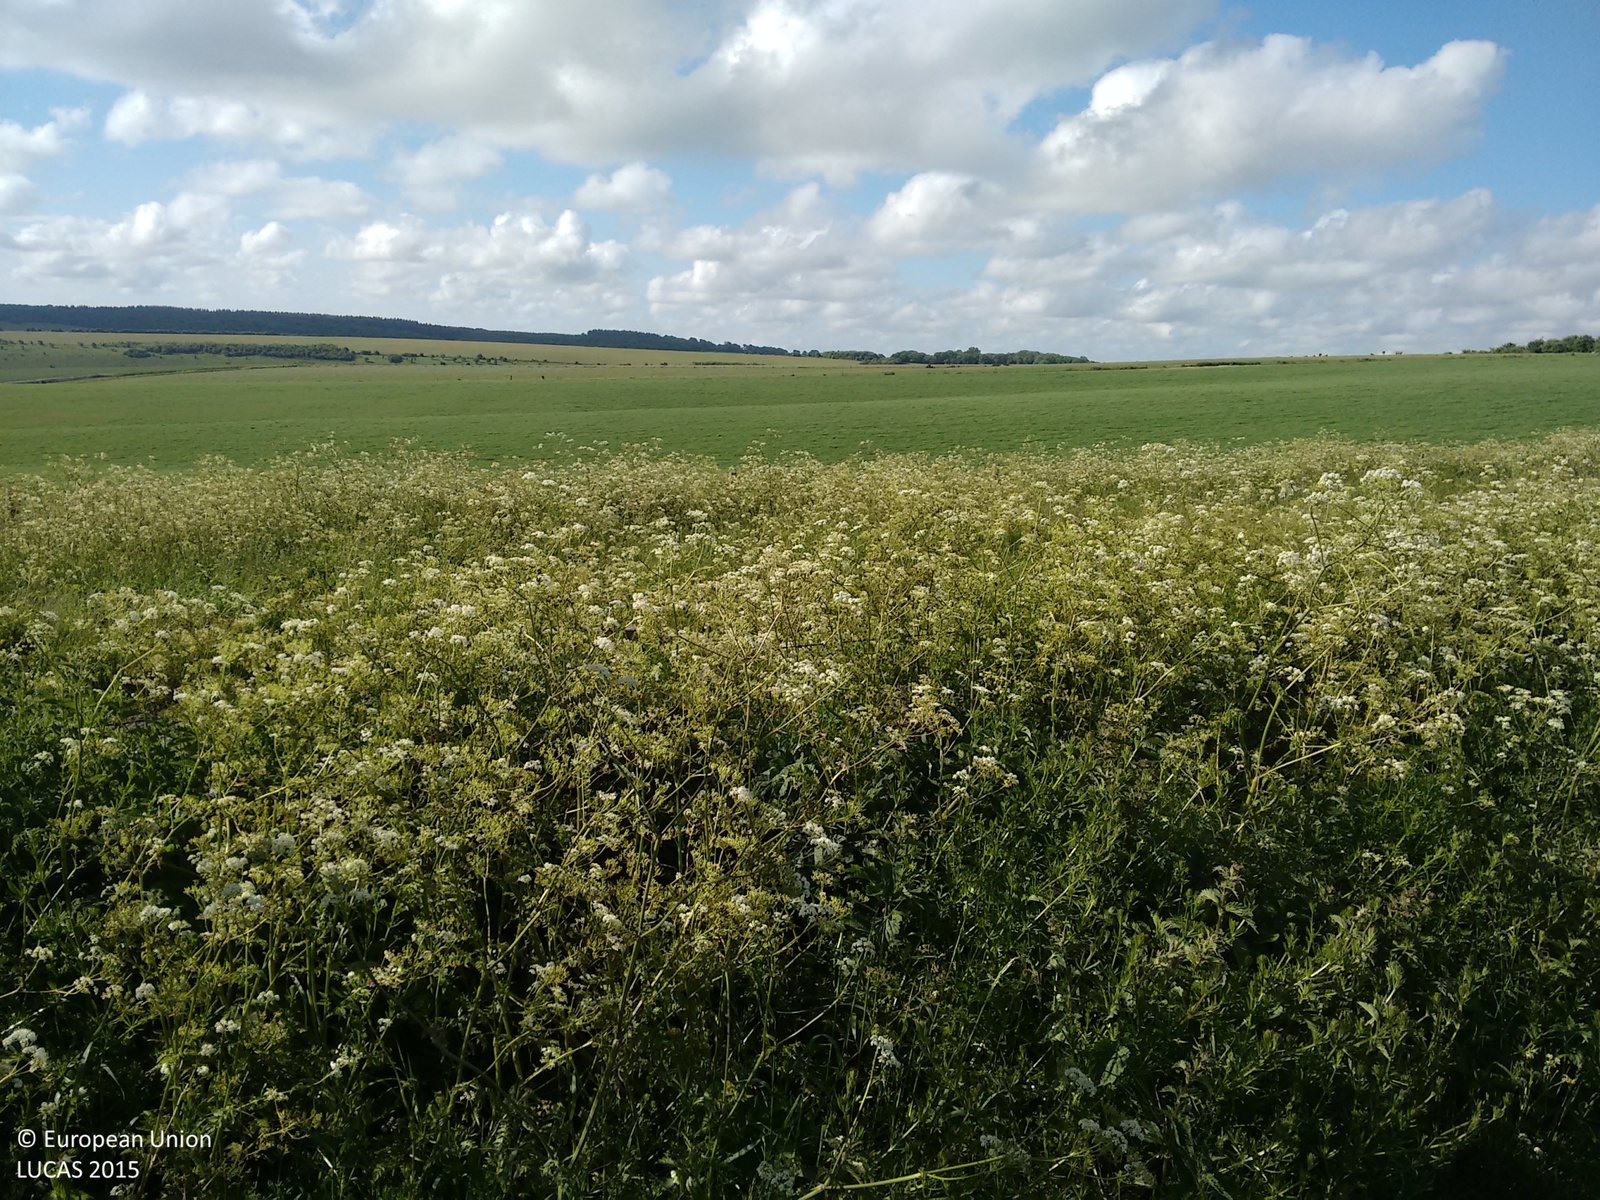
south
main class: Cropland
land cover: Common wheat
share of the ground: > 75 %
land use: Agriculture (excluding fallow land and kitchen gardens)
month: June
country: GB
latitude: 51.1513
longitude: -2.1410
